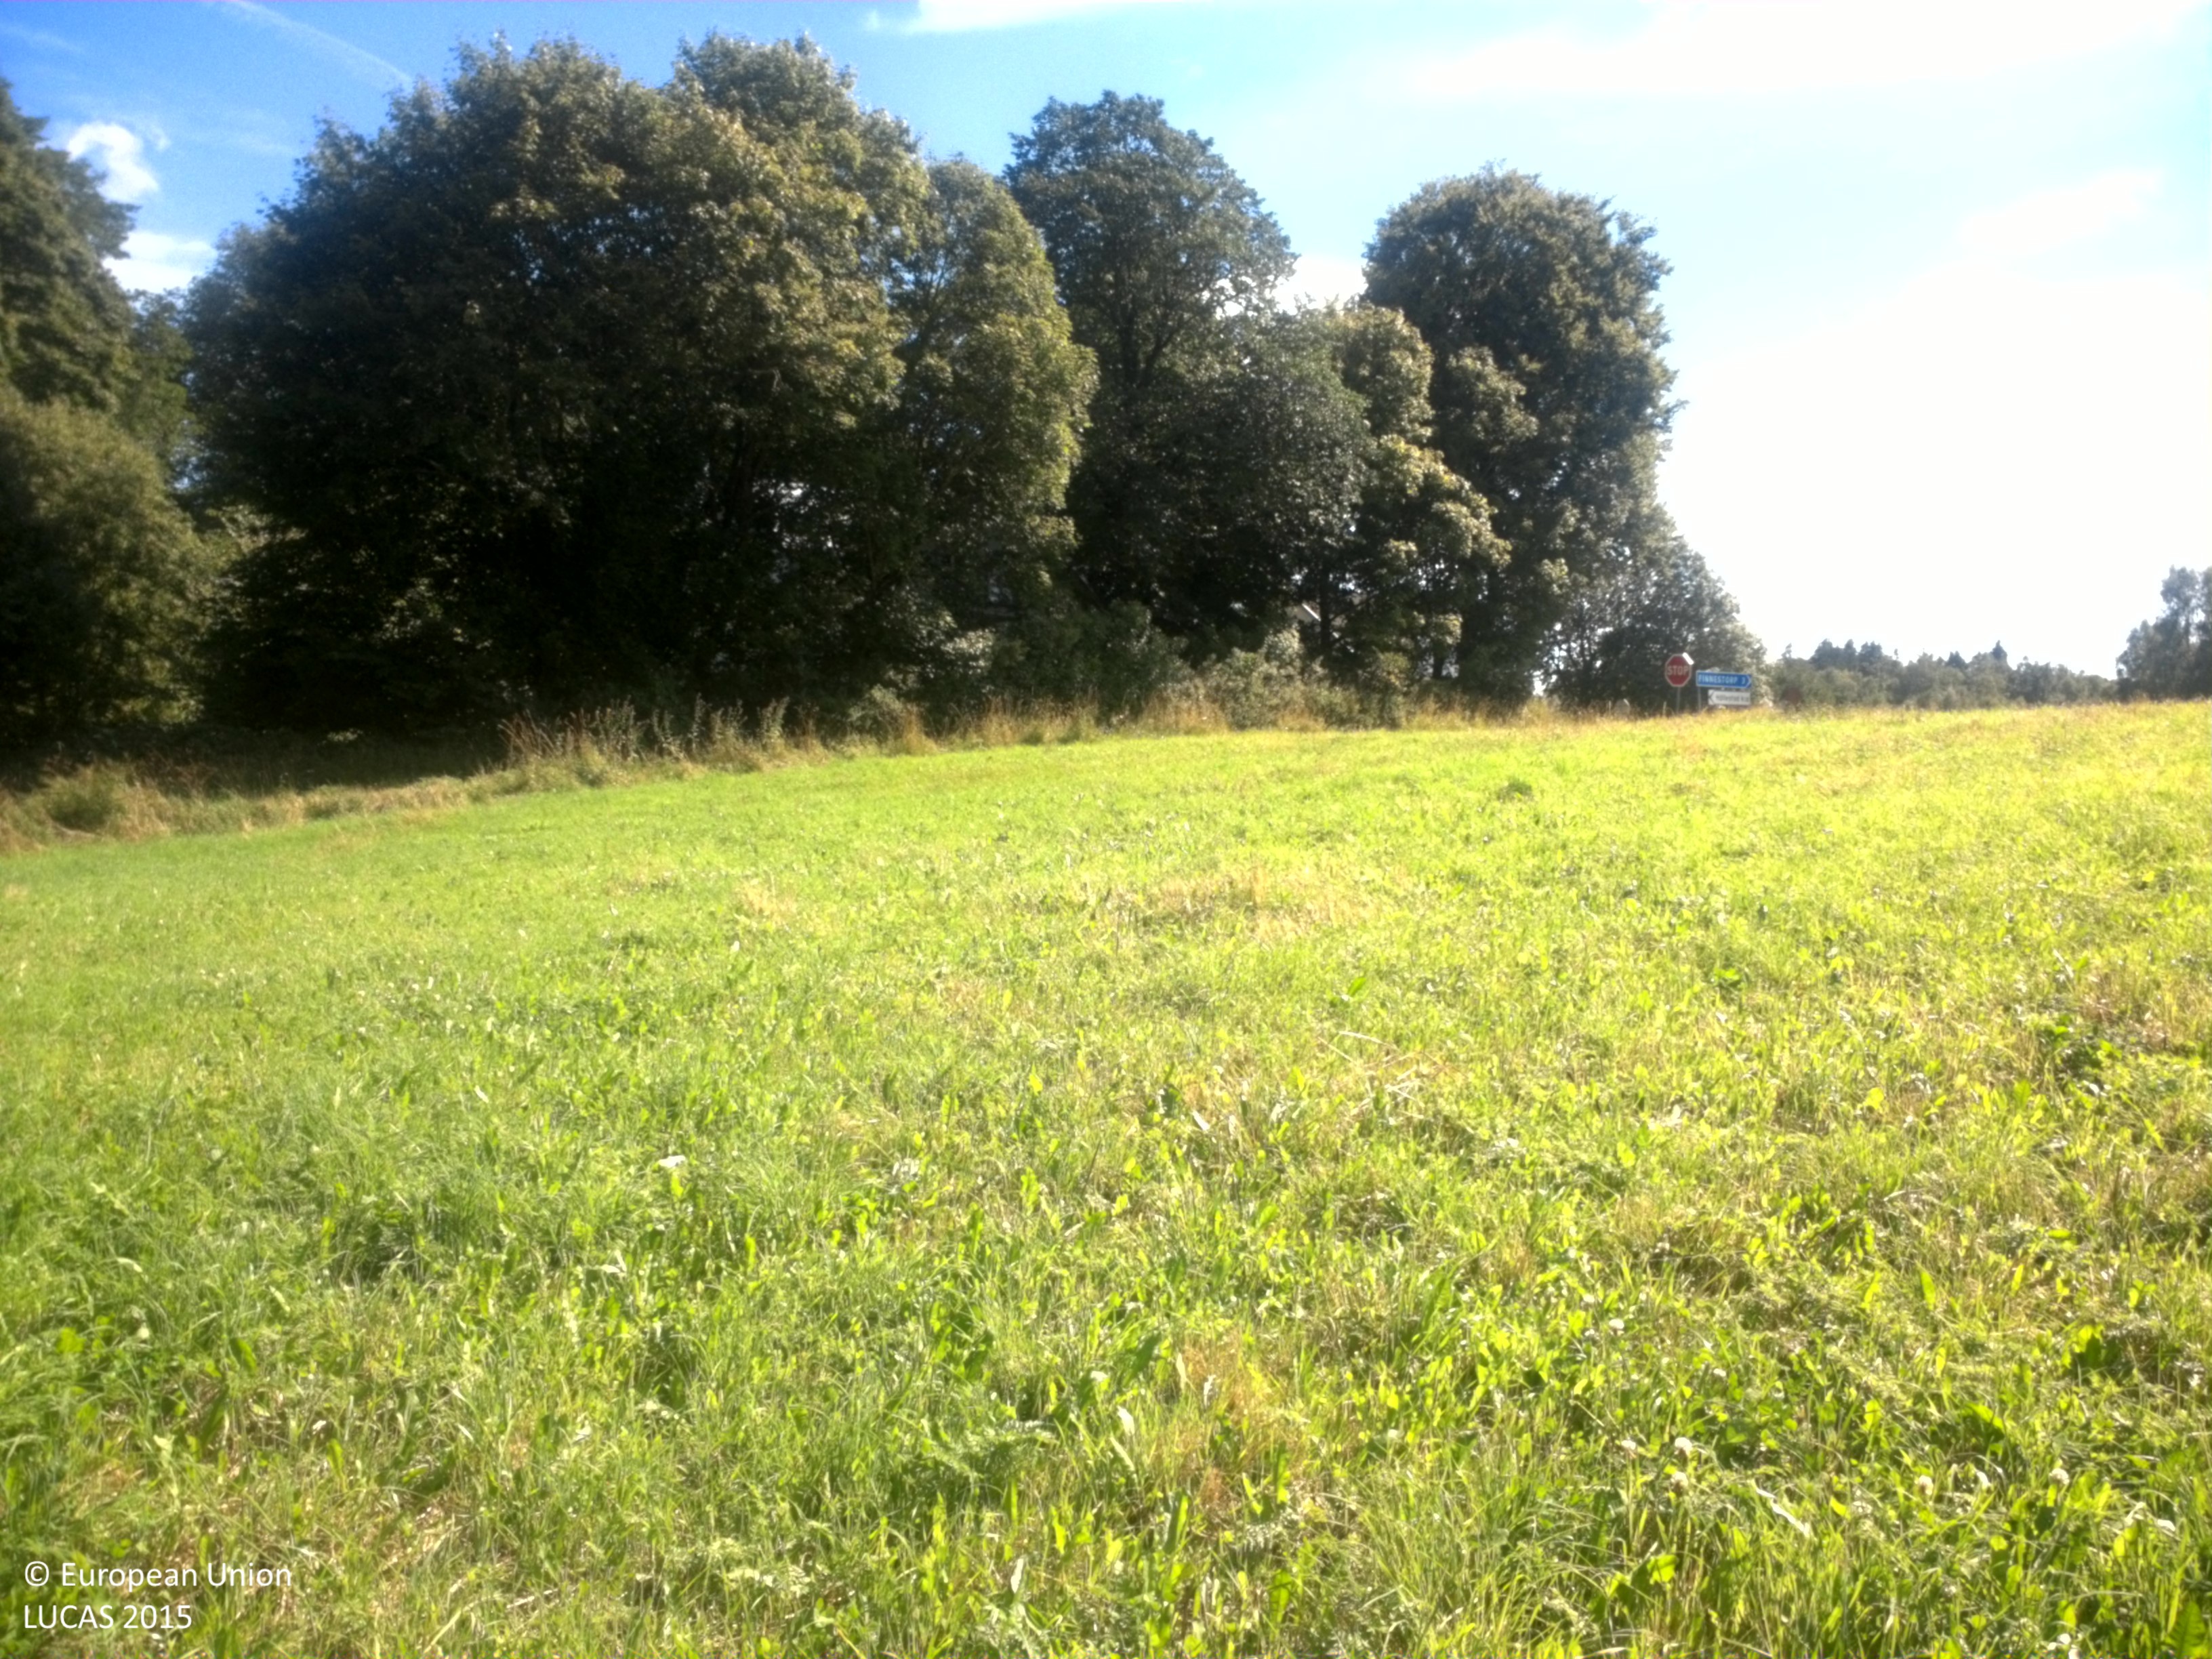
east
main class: Grassland
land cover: Grassland without tree/shrub cover
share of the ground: > 75 %
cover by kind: herbaceous plants 100 %
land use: Agriculture (excluding fallow land and kitchen gardens)
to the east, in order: Grassland without tree/shrub cover; Shruby margins; Paved roads, cycling and walking lanes; Grass margins; Groves; Artificial constructions in urban areas; Grassland without tree/shrub cover; Paved roads, cycling and walking lanes; Grass margins; Shruby margins; Grassland without tree/shrub cover
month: August
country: SE
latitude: 58.1078
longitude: 13.2700
